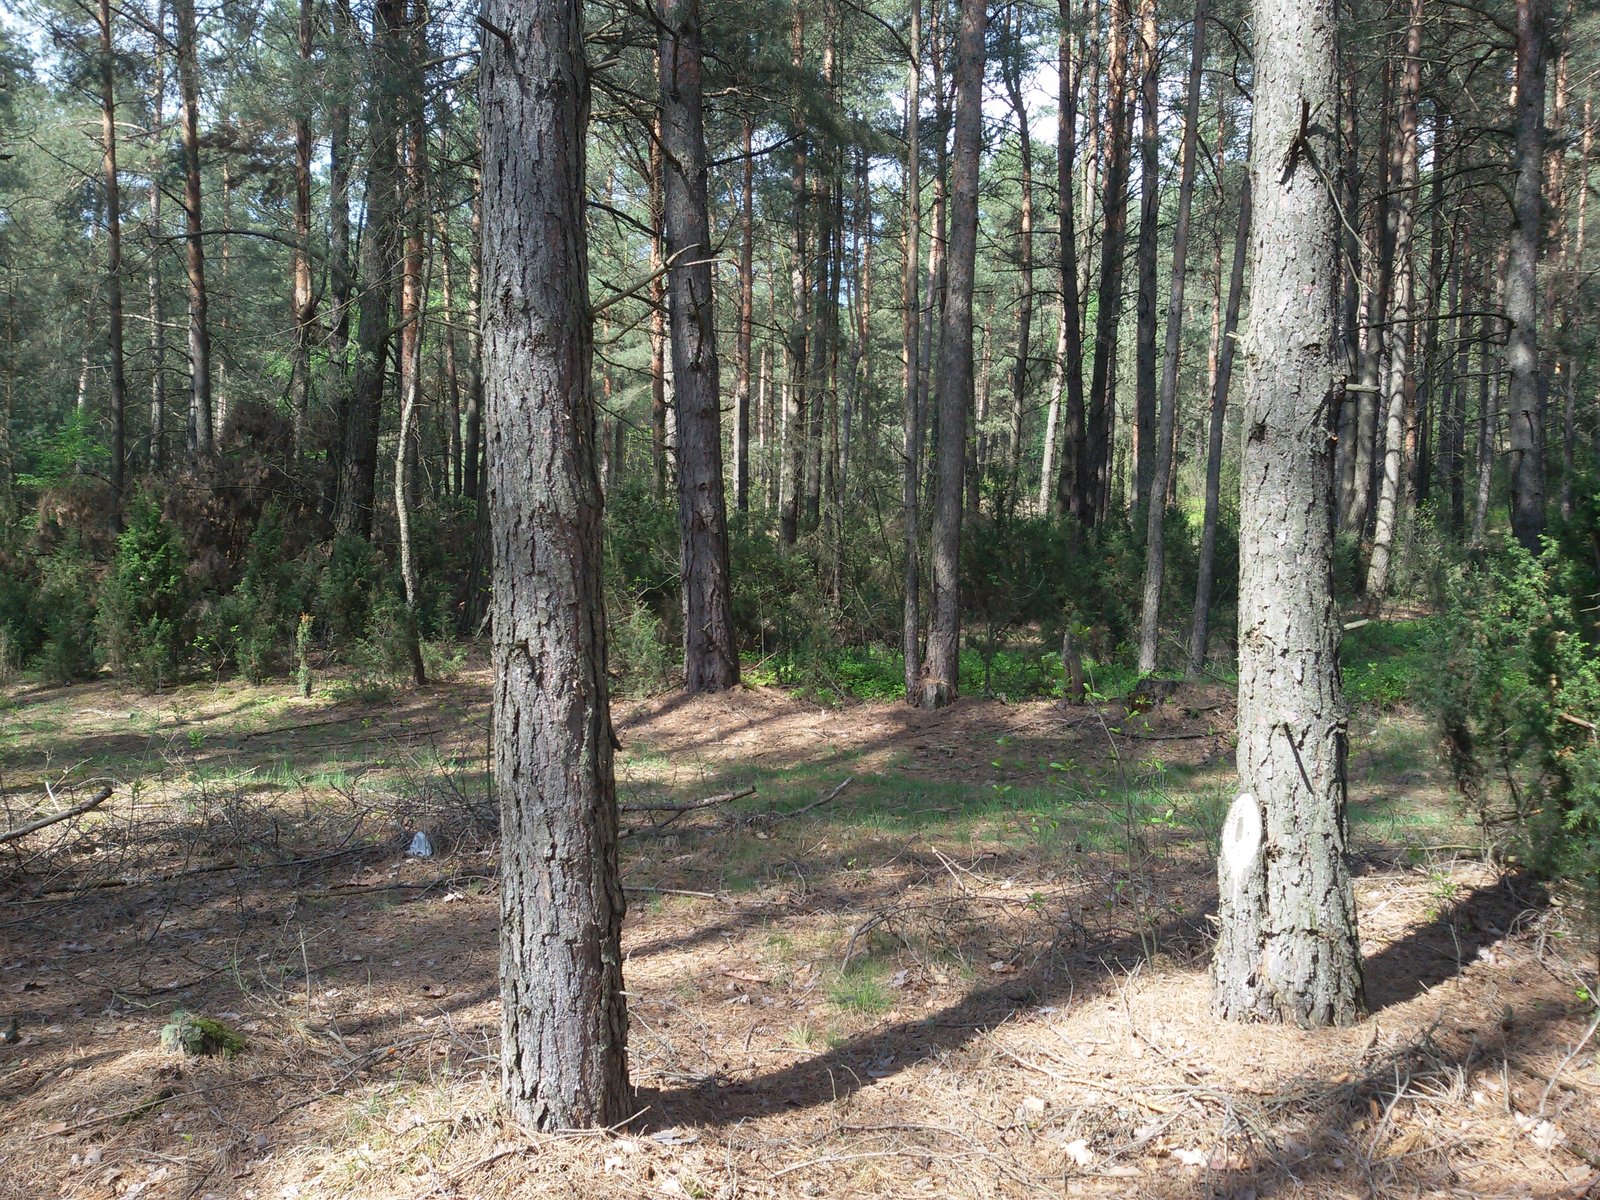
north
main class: Woodland
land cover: Pine dominated coniferous woodland
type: hemiboreal forest and nemoral coniferous forest and mixed broadleaved-coniferous forest
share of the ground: > 75 %
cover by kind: coniferous forest trees 75 %, lichens and mosses 15 %, shrubs 5 %, herbaceous plants 5 %
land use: Forestry
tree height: > 5 m
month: May
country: PL
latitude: 53.0525
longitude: 22.4021
